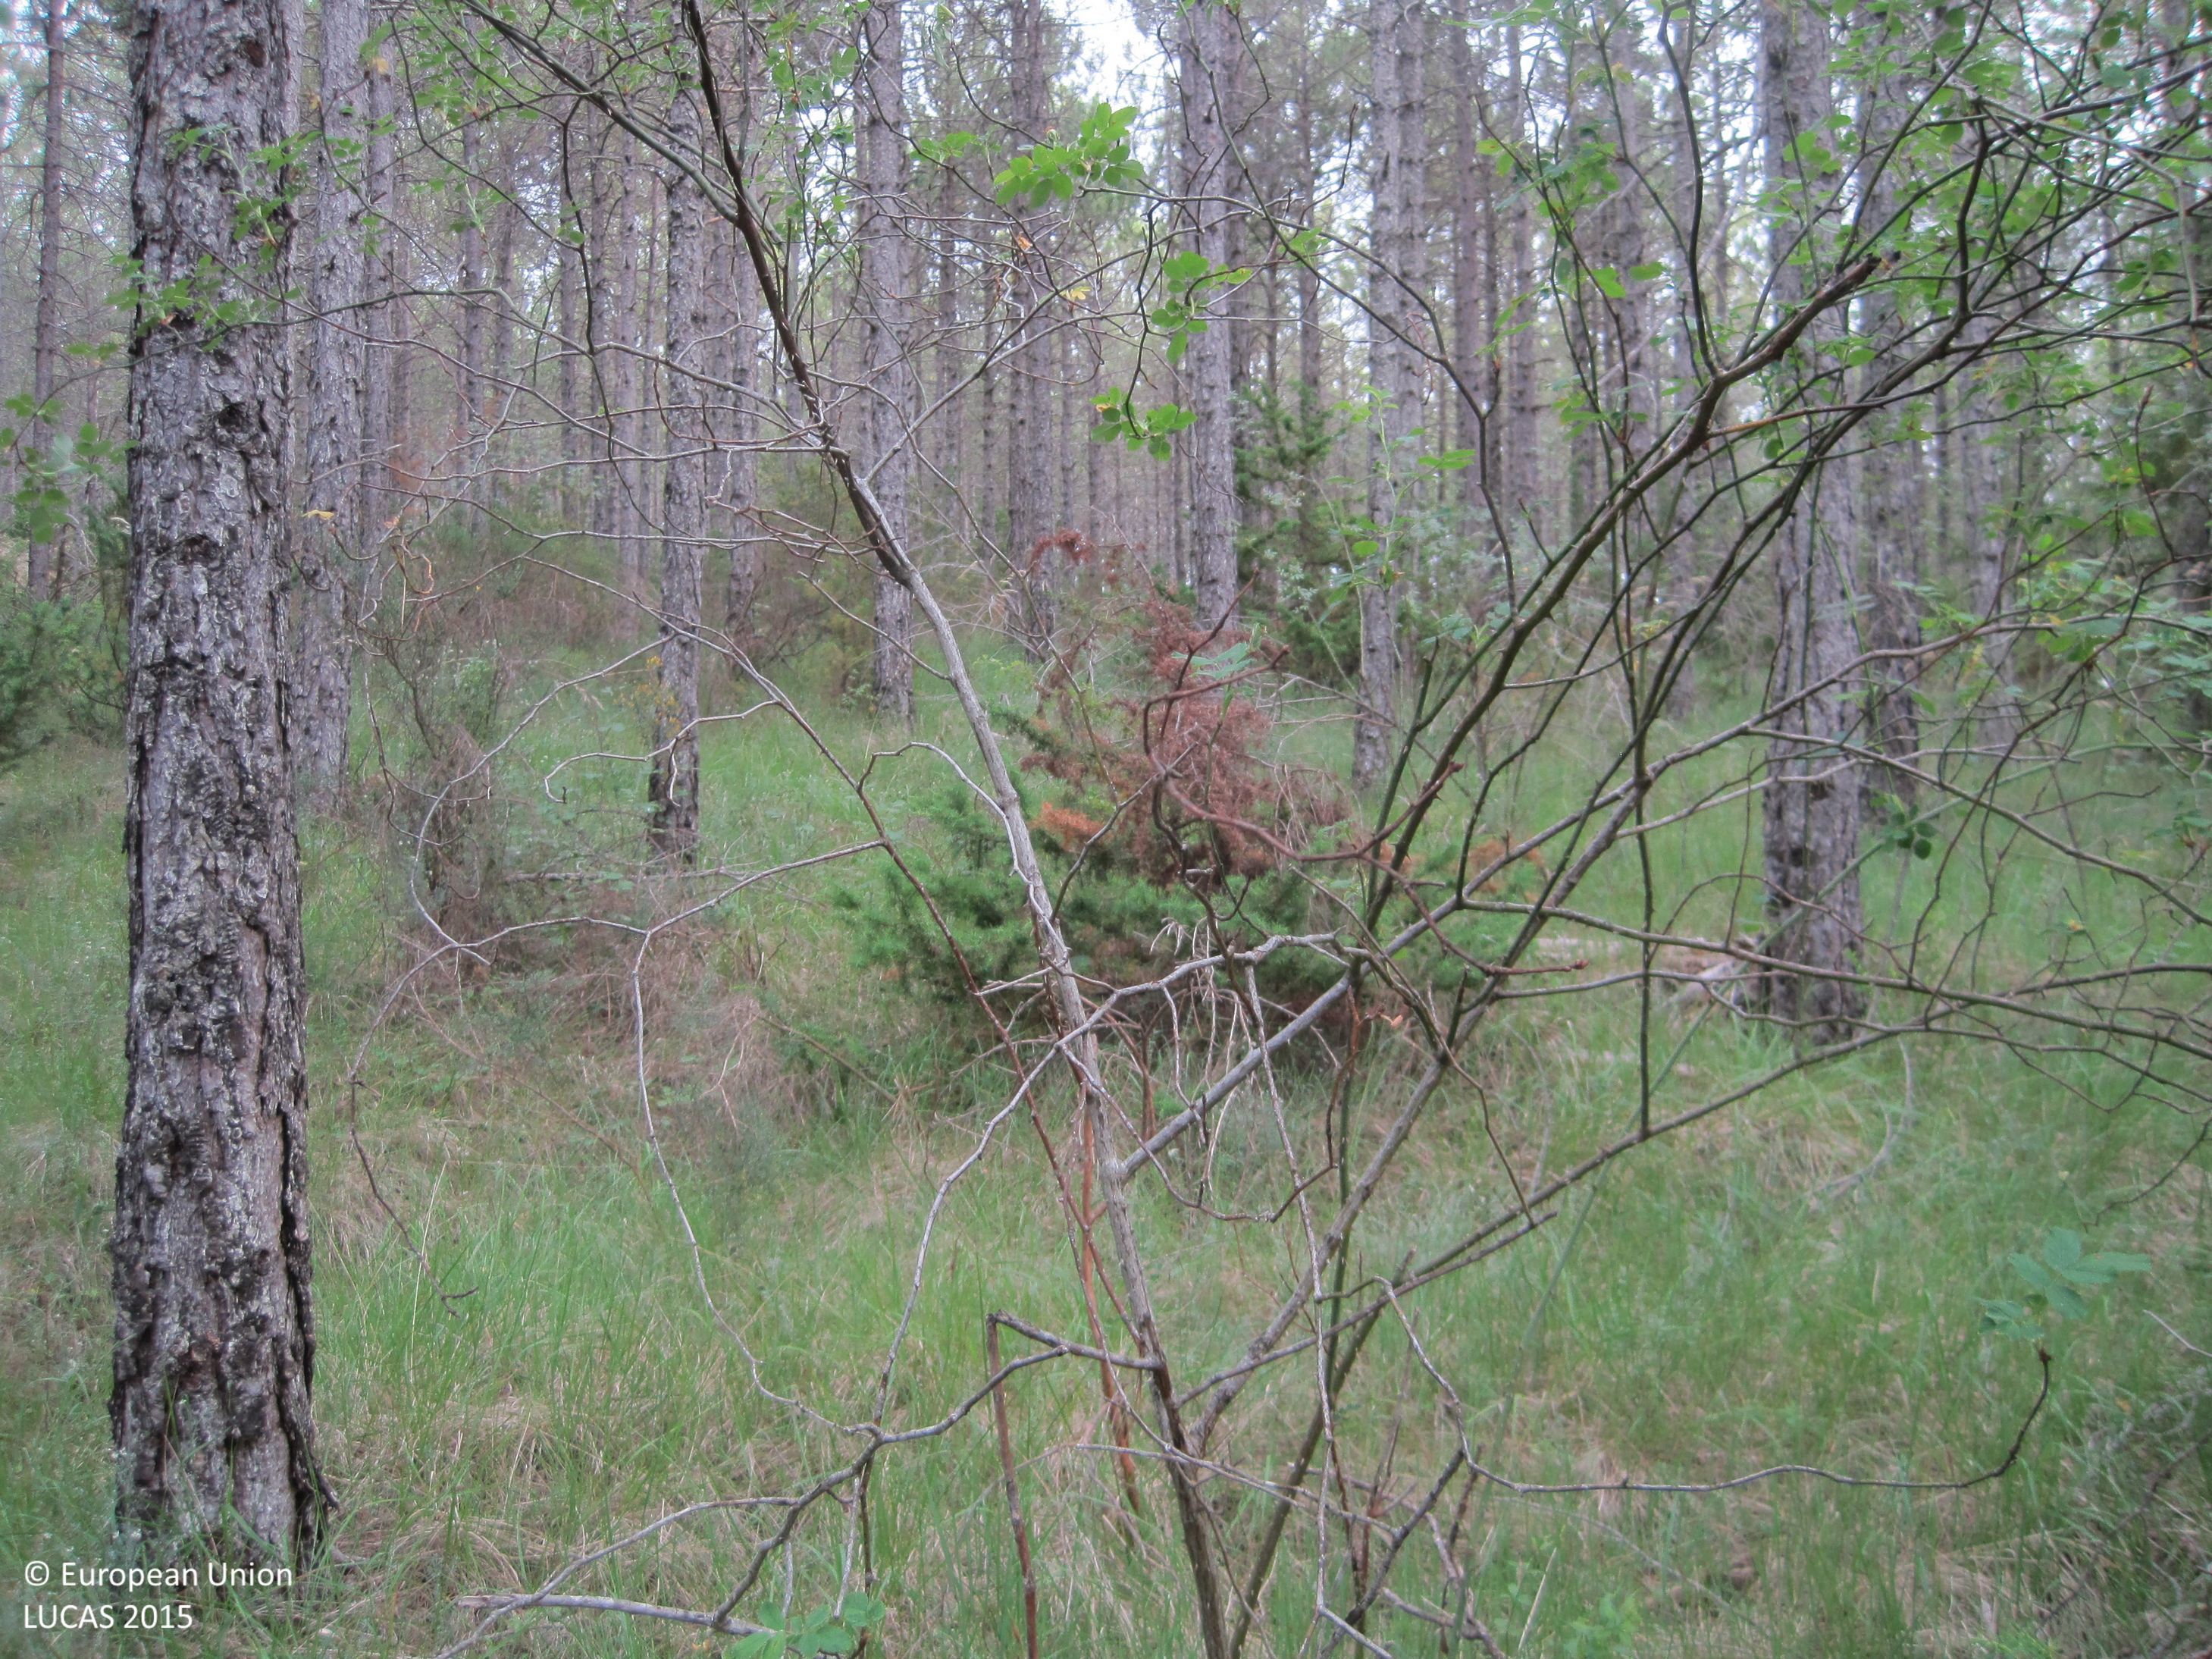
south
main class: Woodland
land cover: Pine dominated coniferous woodland
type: coniferous forest of the mediterranean region
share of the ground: > 75 %
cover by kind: coniferous forest trees 95 %, herbaceous plants 5 %
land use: Forestry
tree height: > 5 m
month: June
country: ES
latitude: 42.7729
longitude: -1.2421
